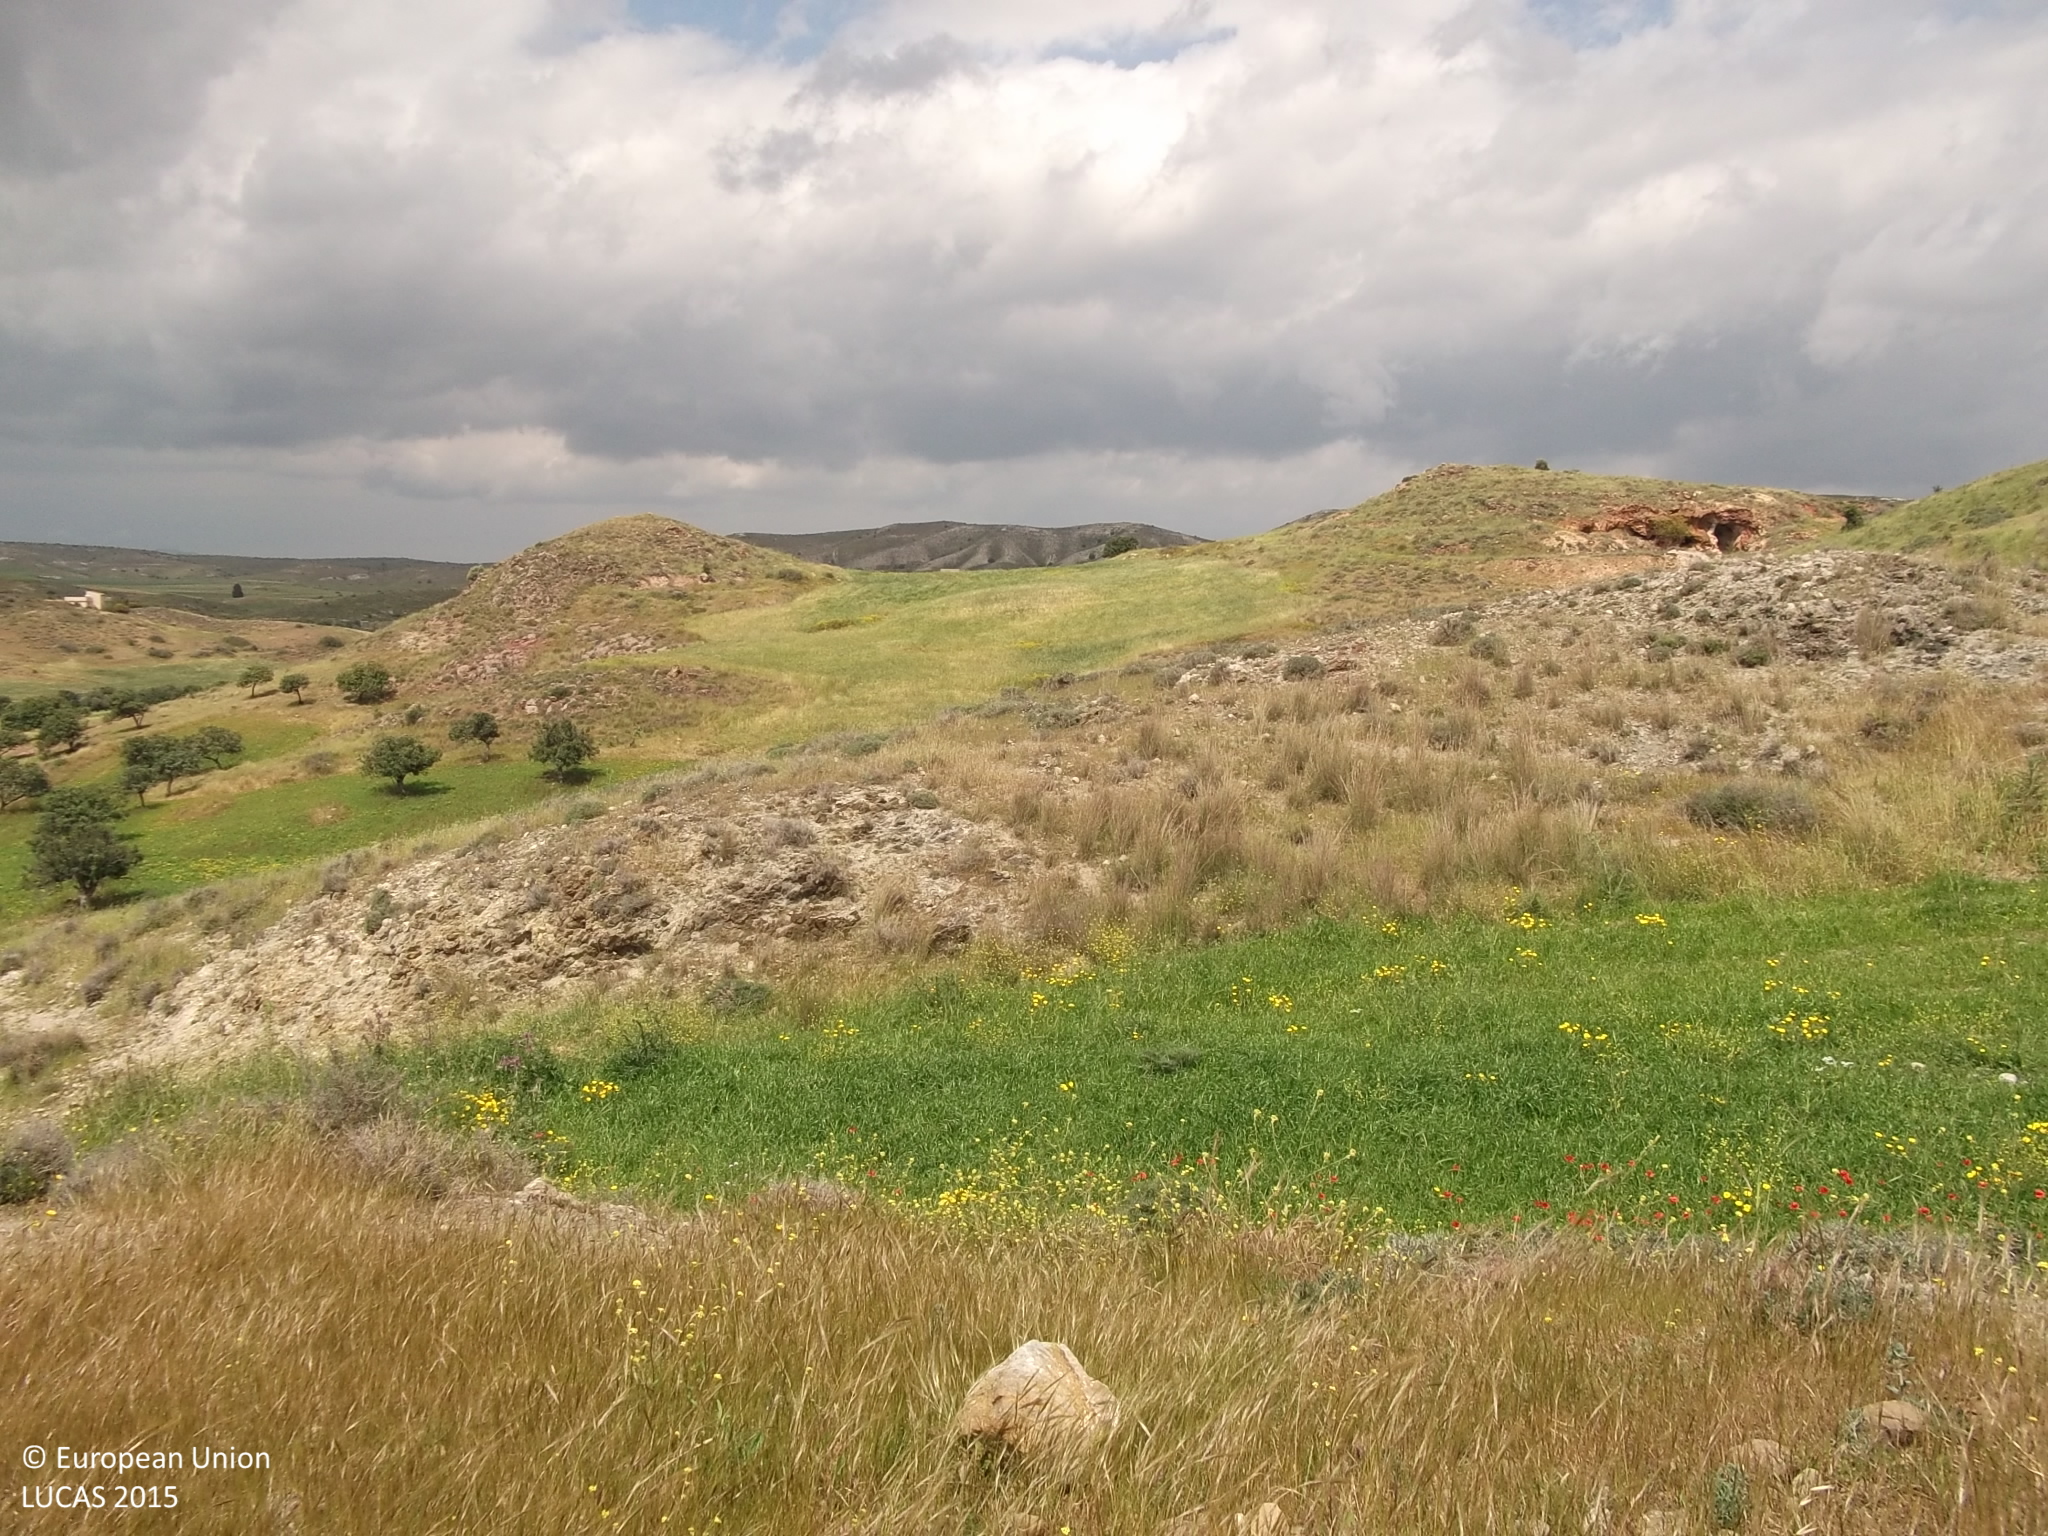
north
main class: Grassland
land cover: Grassland without tree/shrub cover
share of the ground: > 75 %
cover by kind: herbaceous plants 95 %, shrubs 5 %
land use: Semi-natural and natural areas not in use
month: April
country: CY
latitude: 35.0269
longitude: 33.6222
